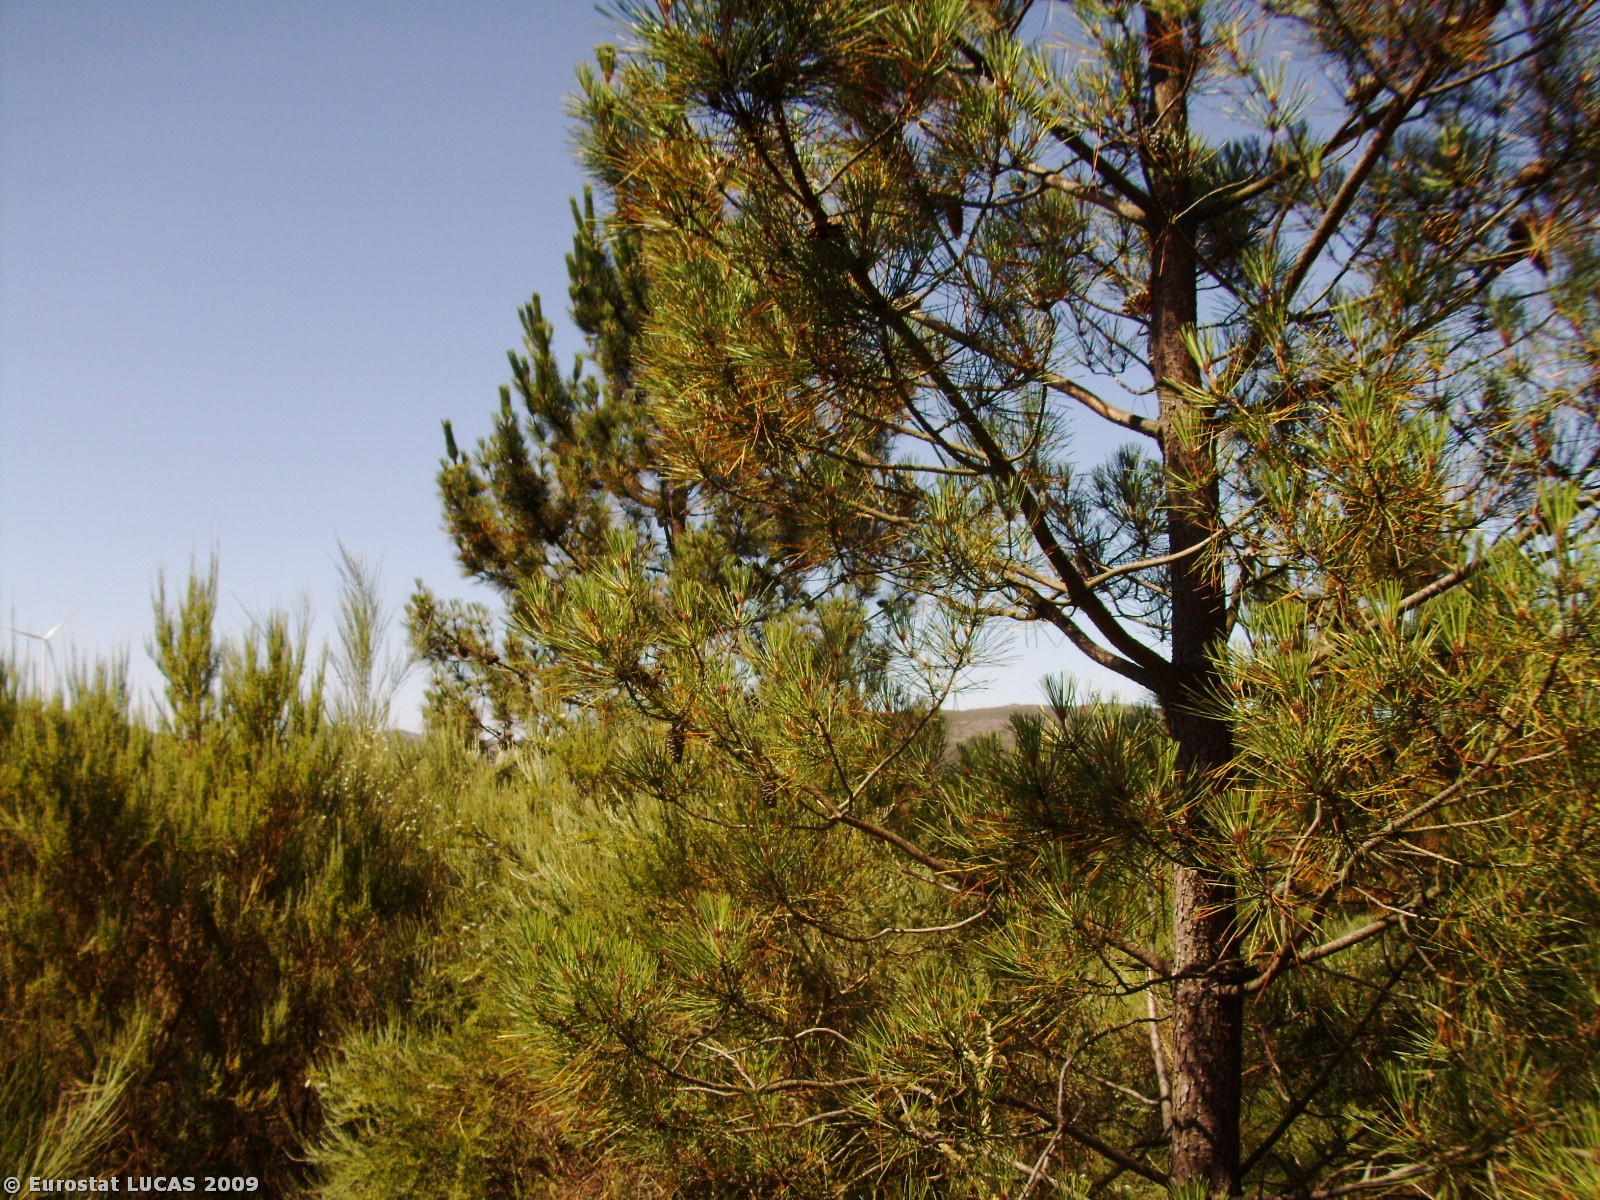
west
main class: Woodland
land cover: Coniferous woodland
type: coniferous forest of the mediterranean region
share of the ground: 25 - 50 %
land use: Forestry
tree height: > 5 m
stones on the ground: < 10 %
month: July
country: PT
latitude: 40.9790
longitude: -7.7505
